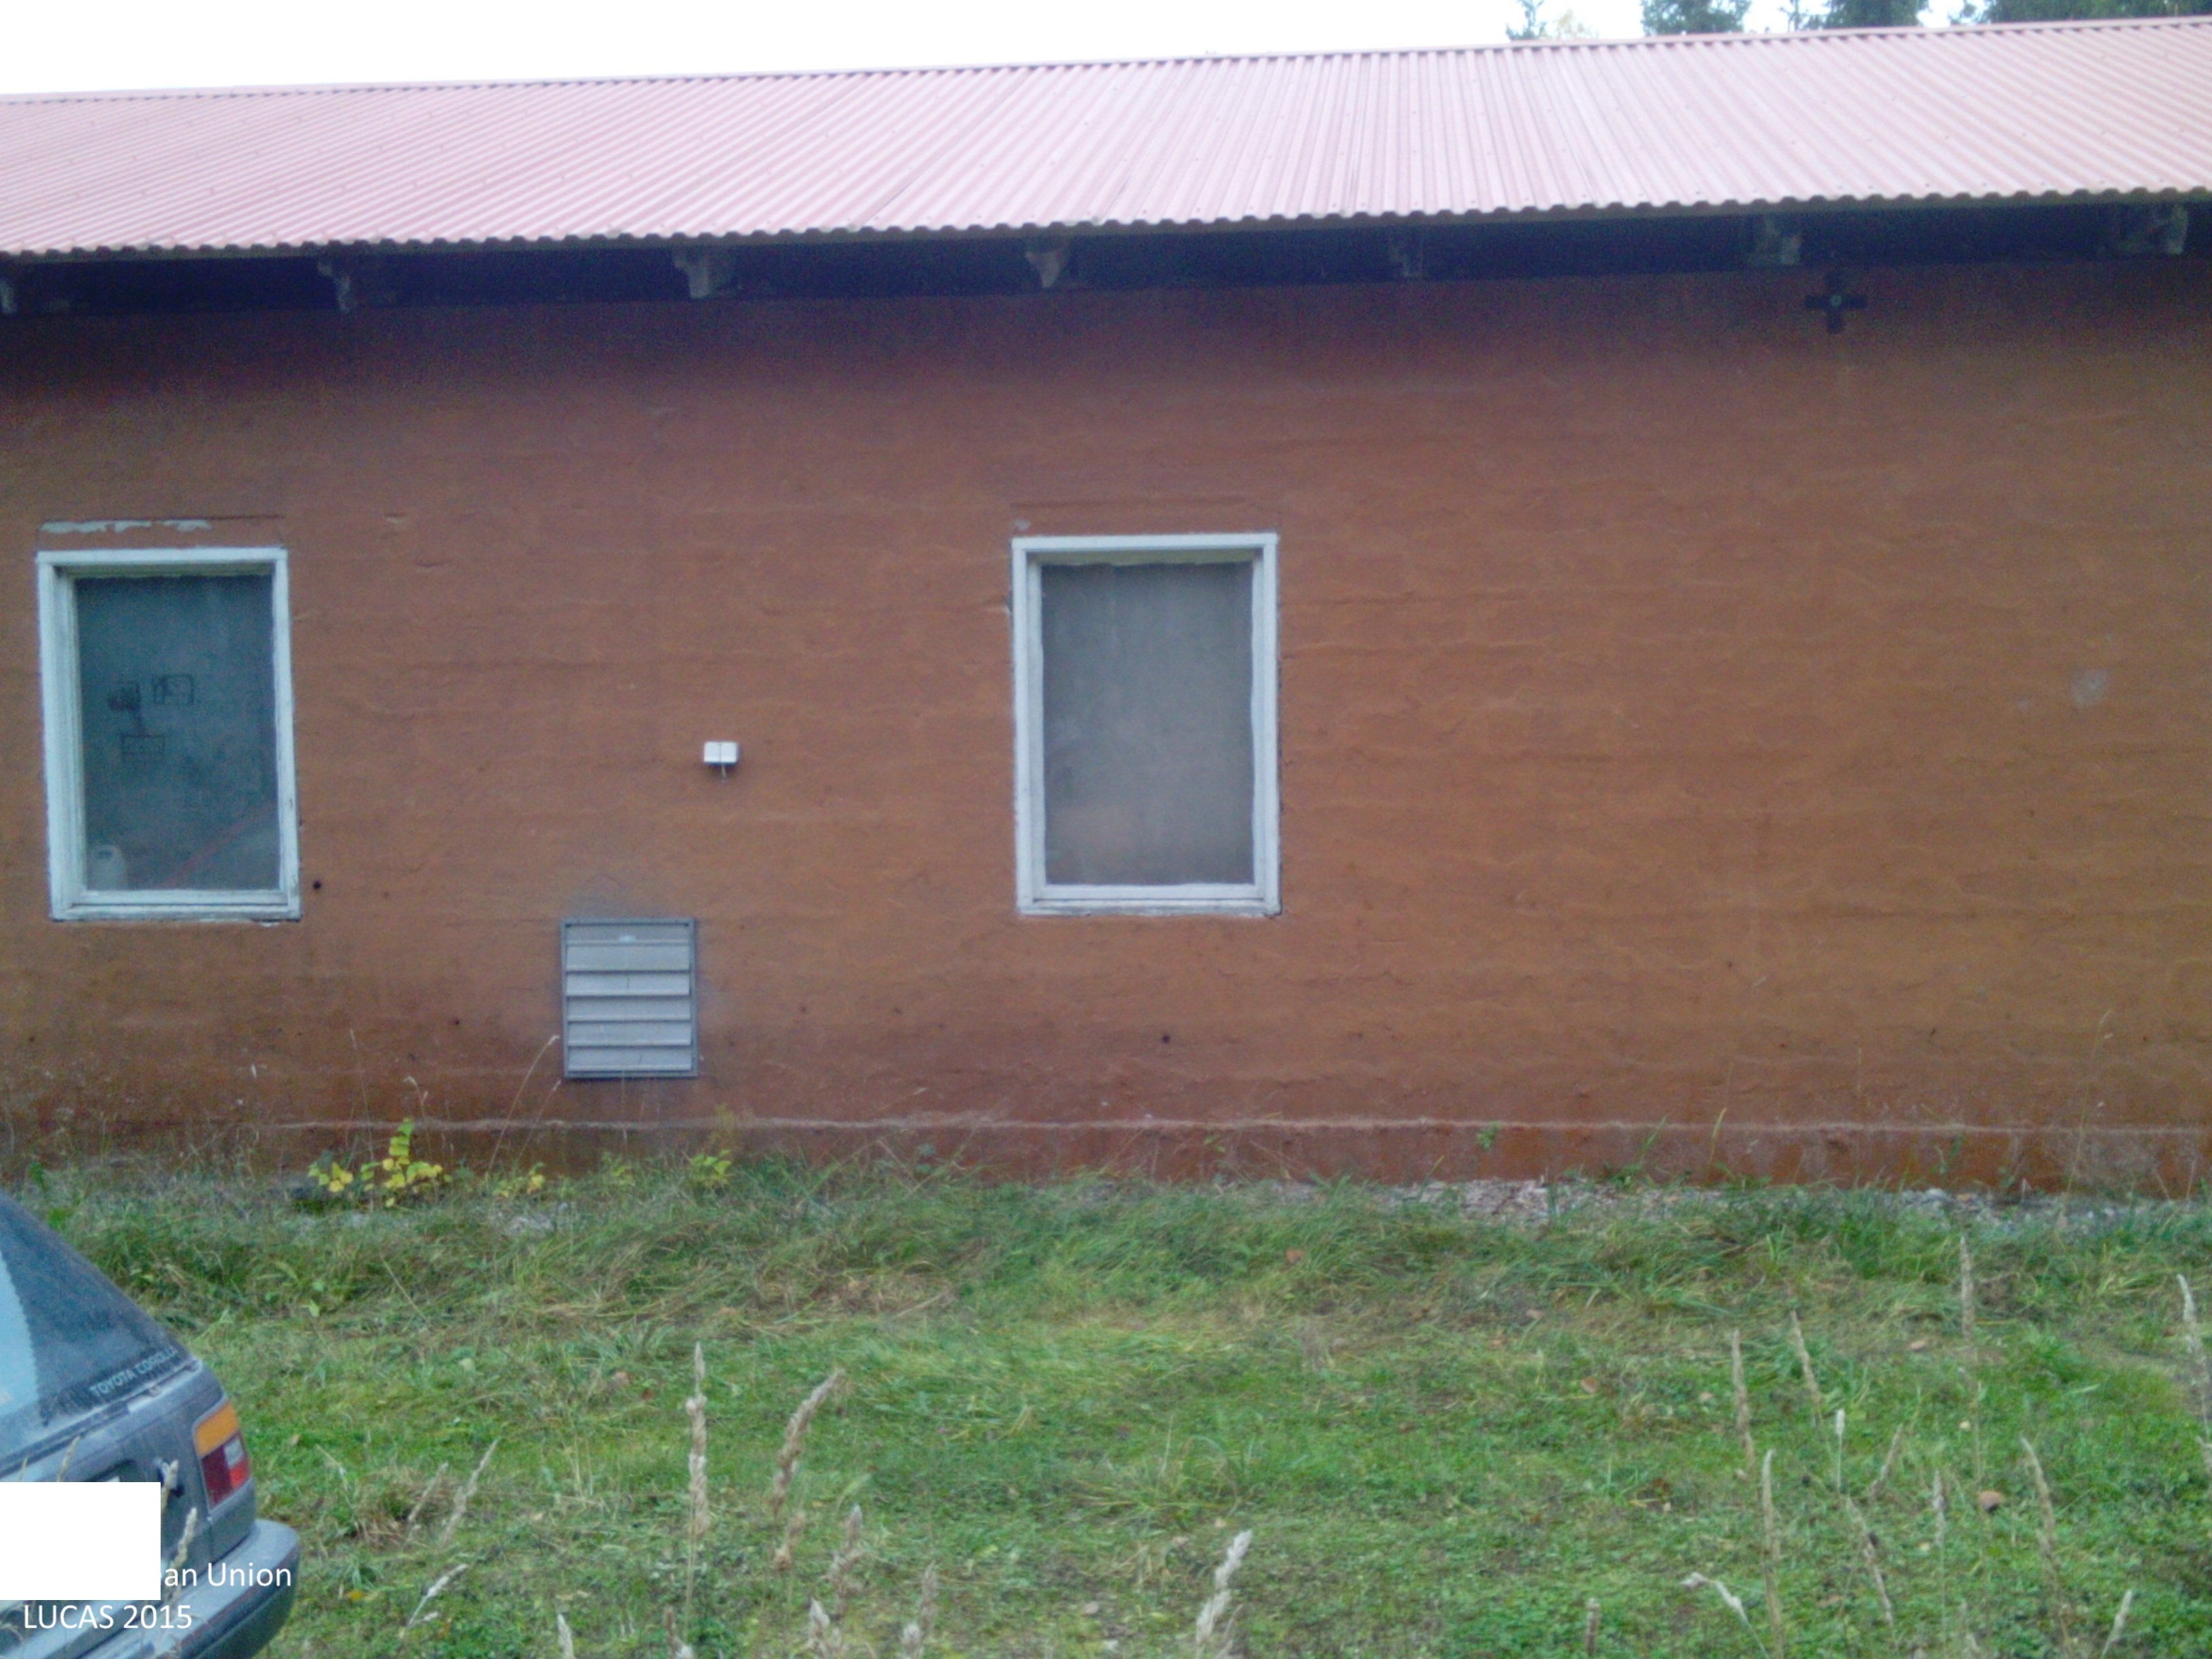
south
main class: Shrubland
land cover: Shrubland with sparse tree cover
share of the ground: 25 - 50 %
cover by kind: shrubs 45 %, herbaceous plants 40 %, broadleaved forest trees 5 %
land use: Semi-natural and natural areas not in use
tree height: < 5 m
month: October
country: SE
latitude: 58.8569
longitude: 16.4957
